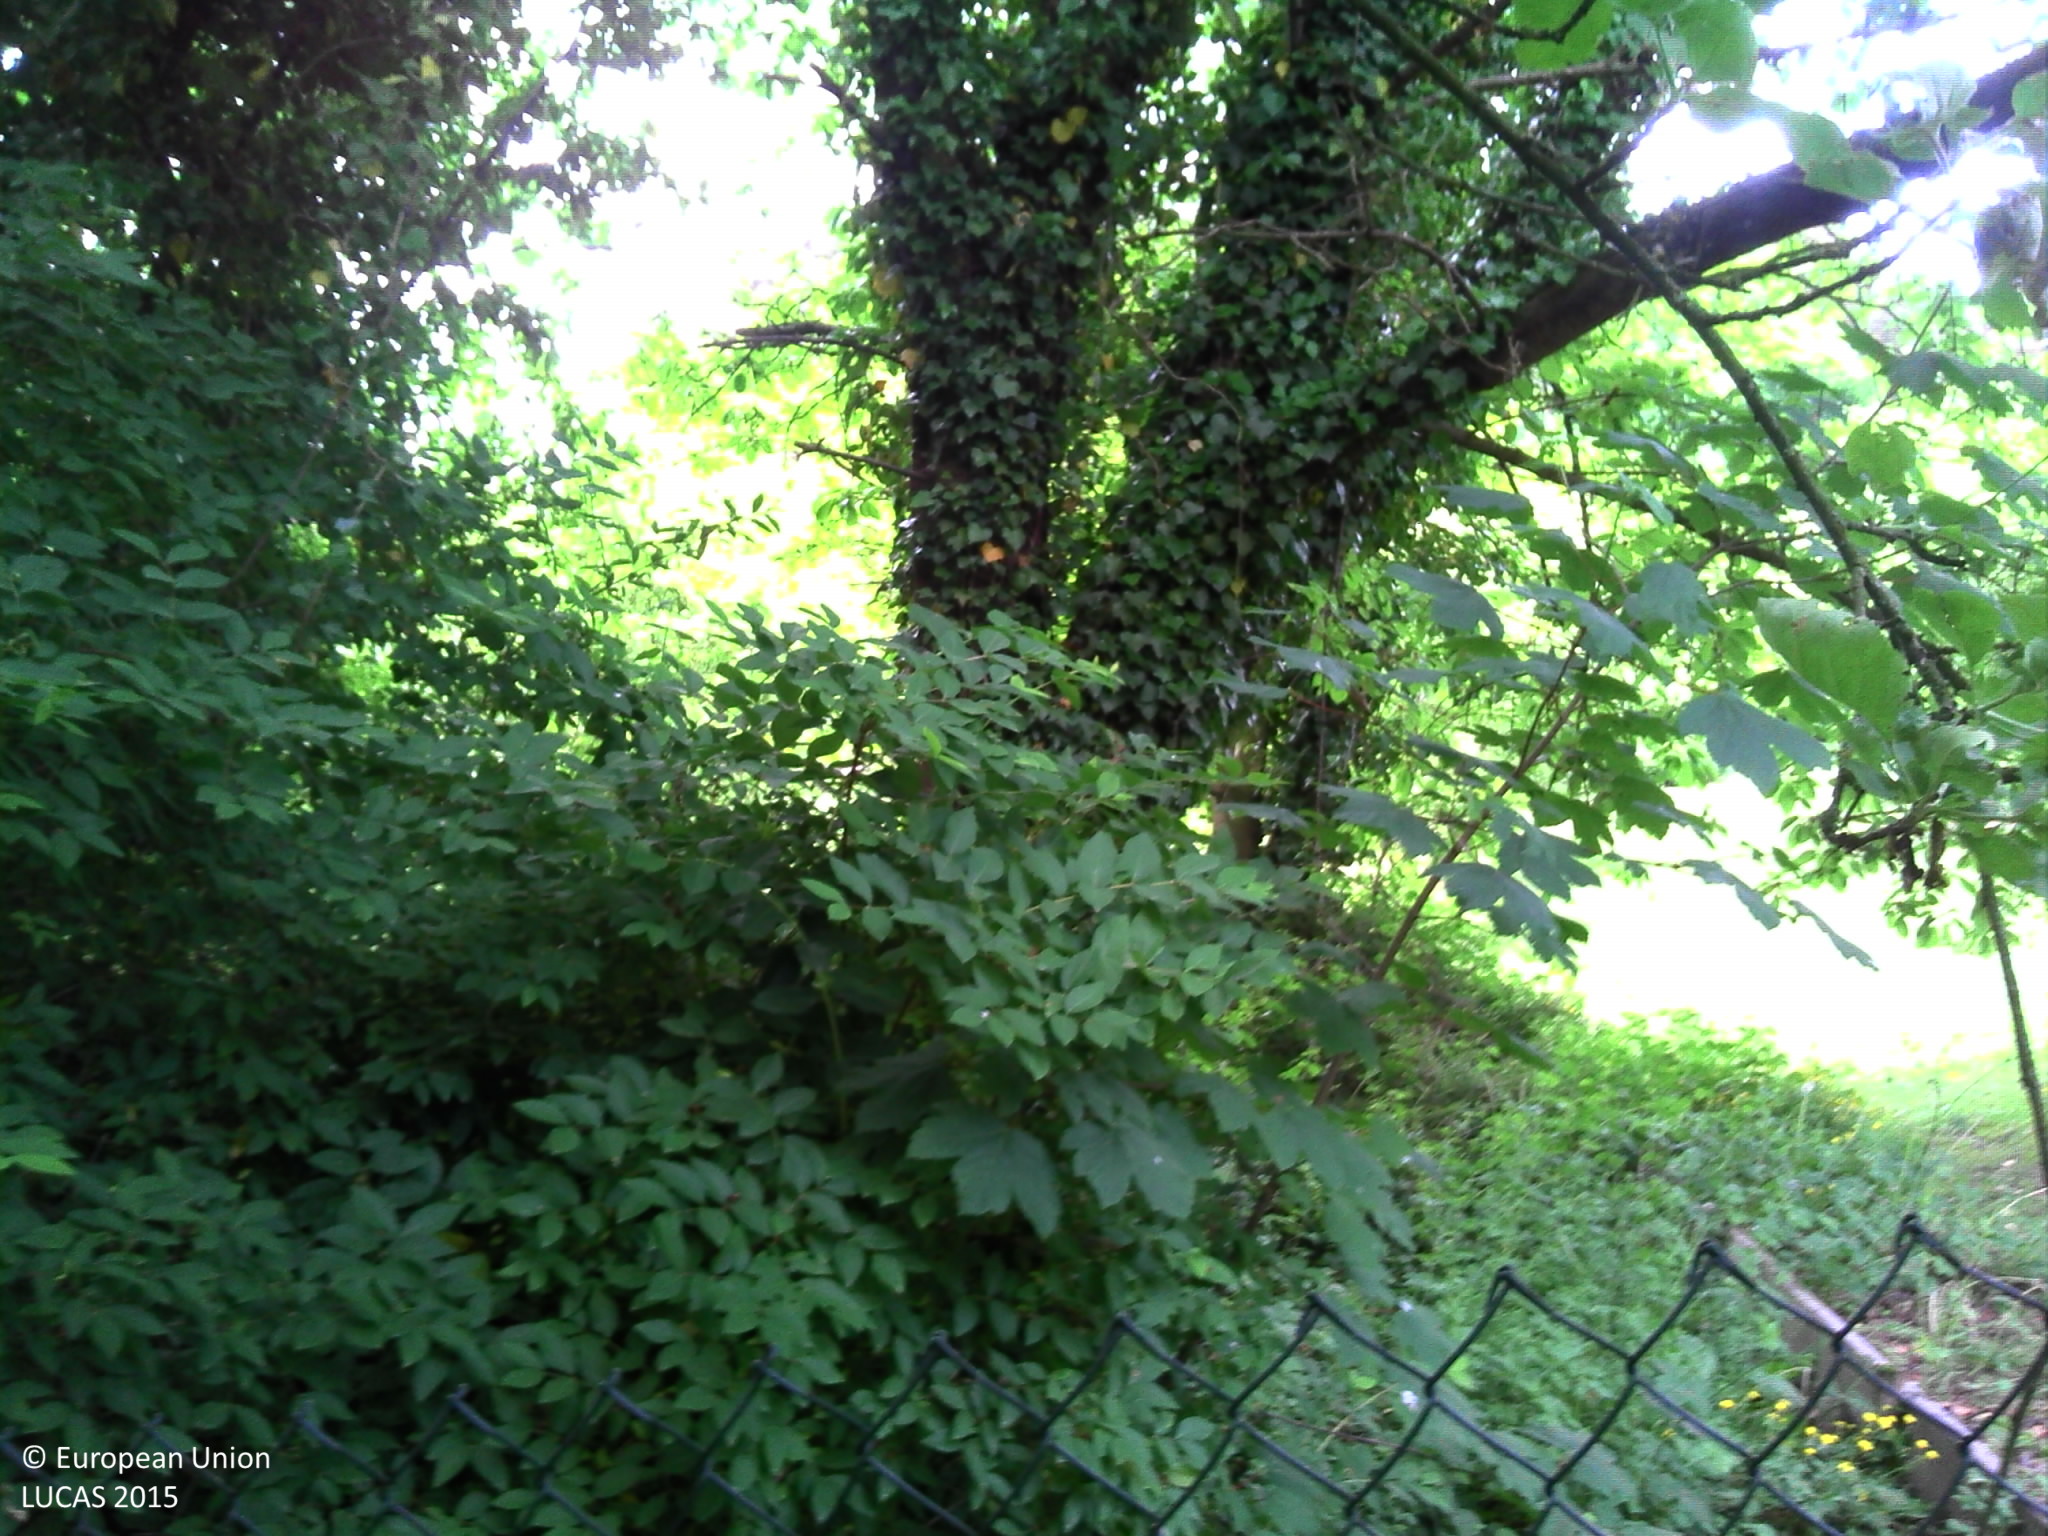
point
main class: Woodland
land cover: Broadleaved woodland
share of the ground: > 75 %
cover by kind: broadleaved forest trees 100 %
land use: Residential
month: May
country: BE
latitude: 50.7270
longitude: 4.6839
